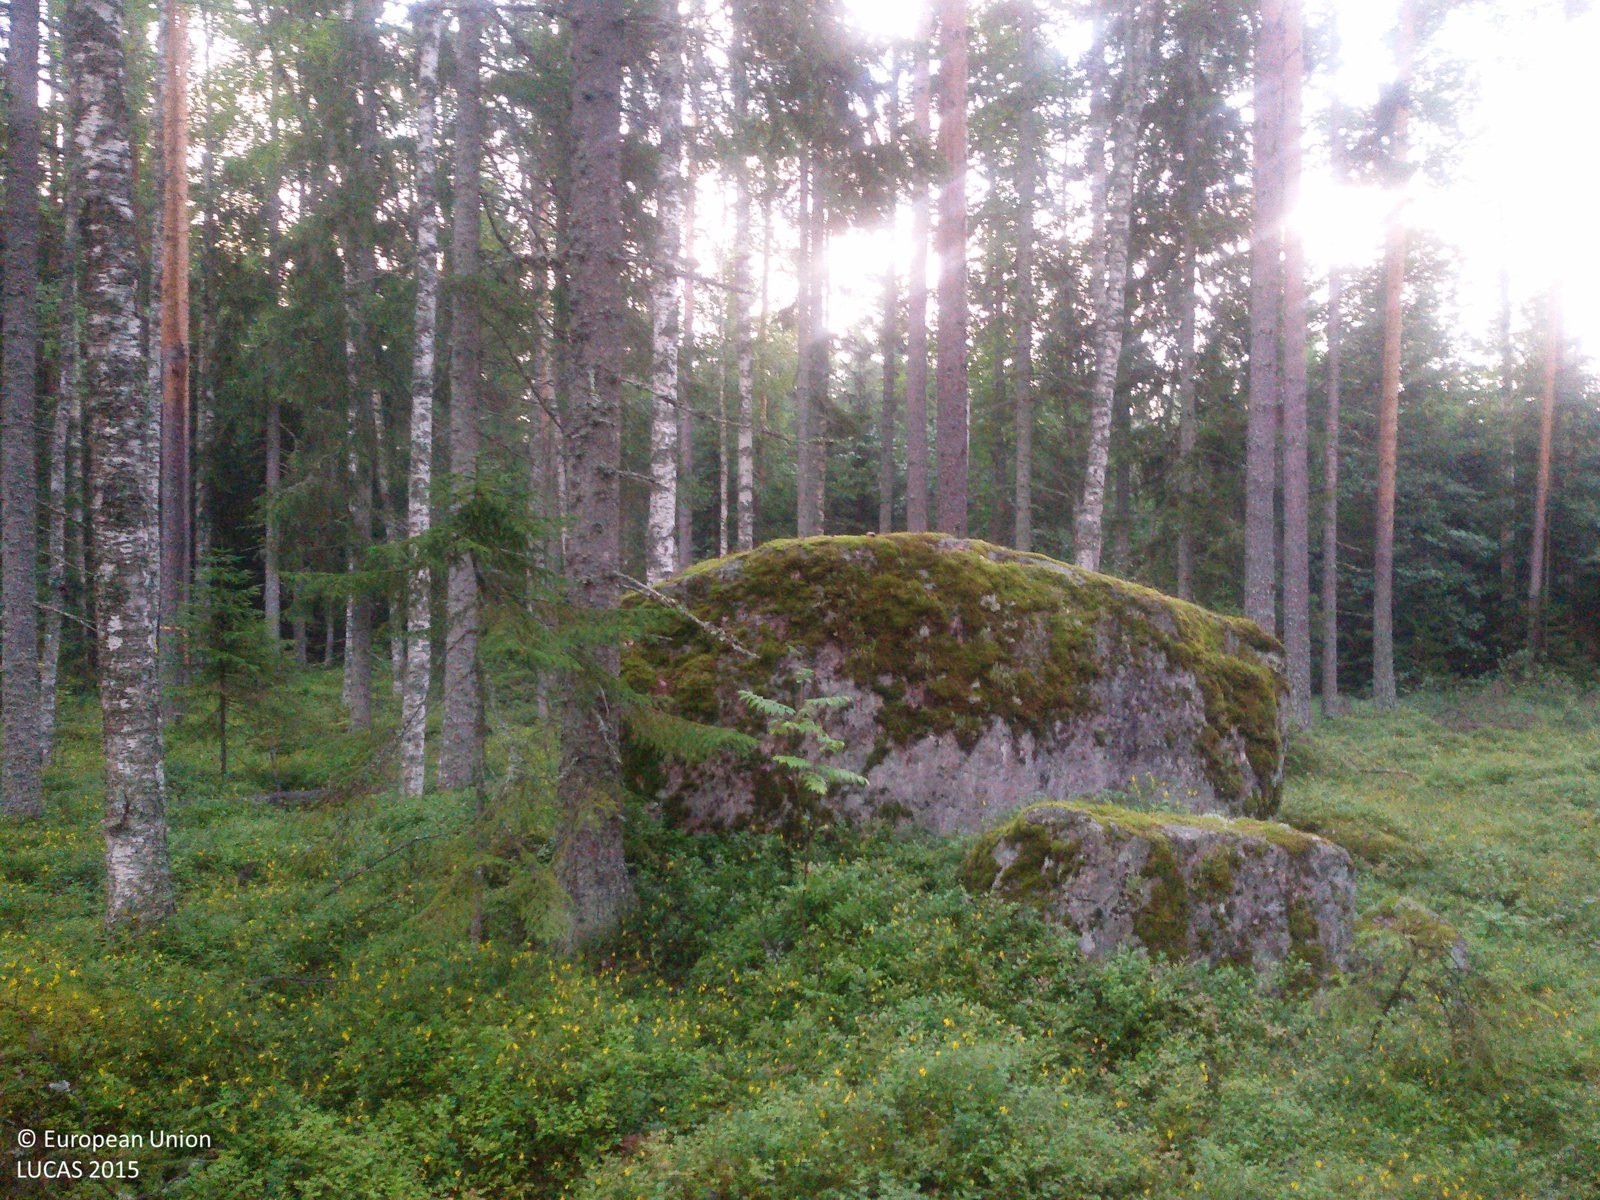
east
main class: Woodland
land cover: Other coniferous woodland
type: boreal forest
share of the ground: 50 - 75 %
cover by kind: coniferous forest trees 55 %, broadleaved forest trees 15 %, shrubs 15 %, lichens and mosses 10 %, herbaceous plants 5 %
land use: Forestry
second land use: Sport
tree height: > 5 m
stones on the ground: > 50 %
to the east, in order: Other coniferous woodland; Pine dominated coniferous woodland; Spruce dominated coniferous woodland; Ditches and canals; Spruce dominated coniferous woodland; Pine dominated coniferous woodland
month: August
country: SE
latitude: 60.7991
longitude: 16.6944
